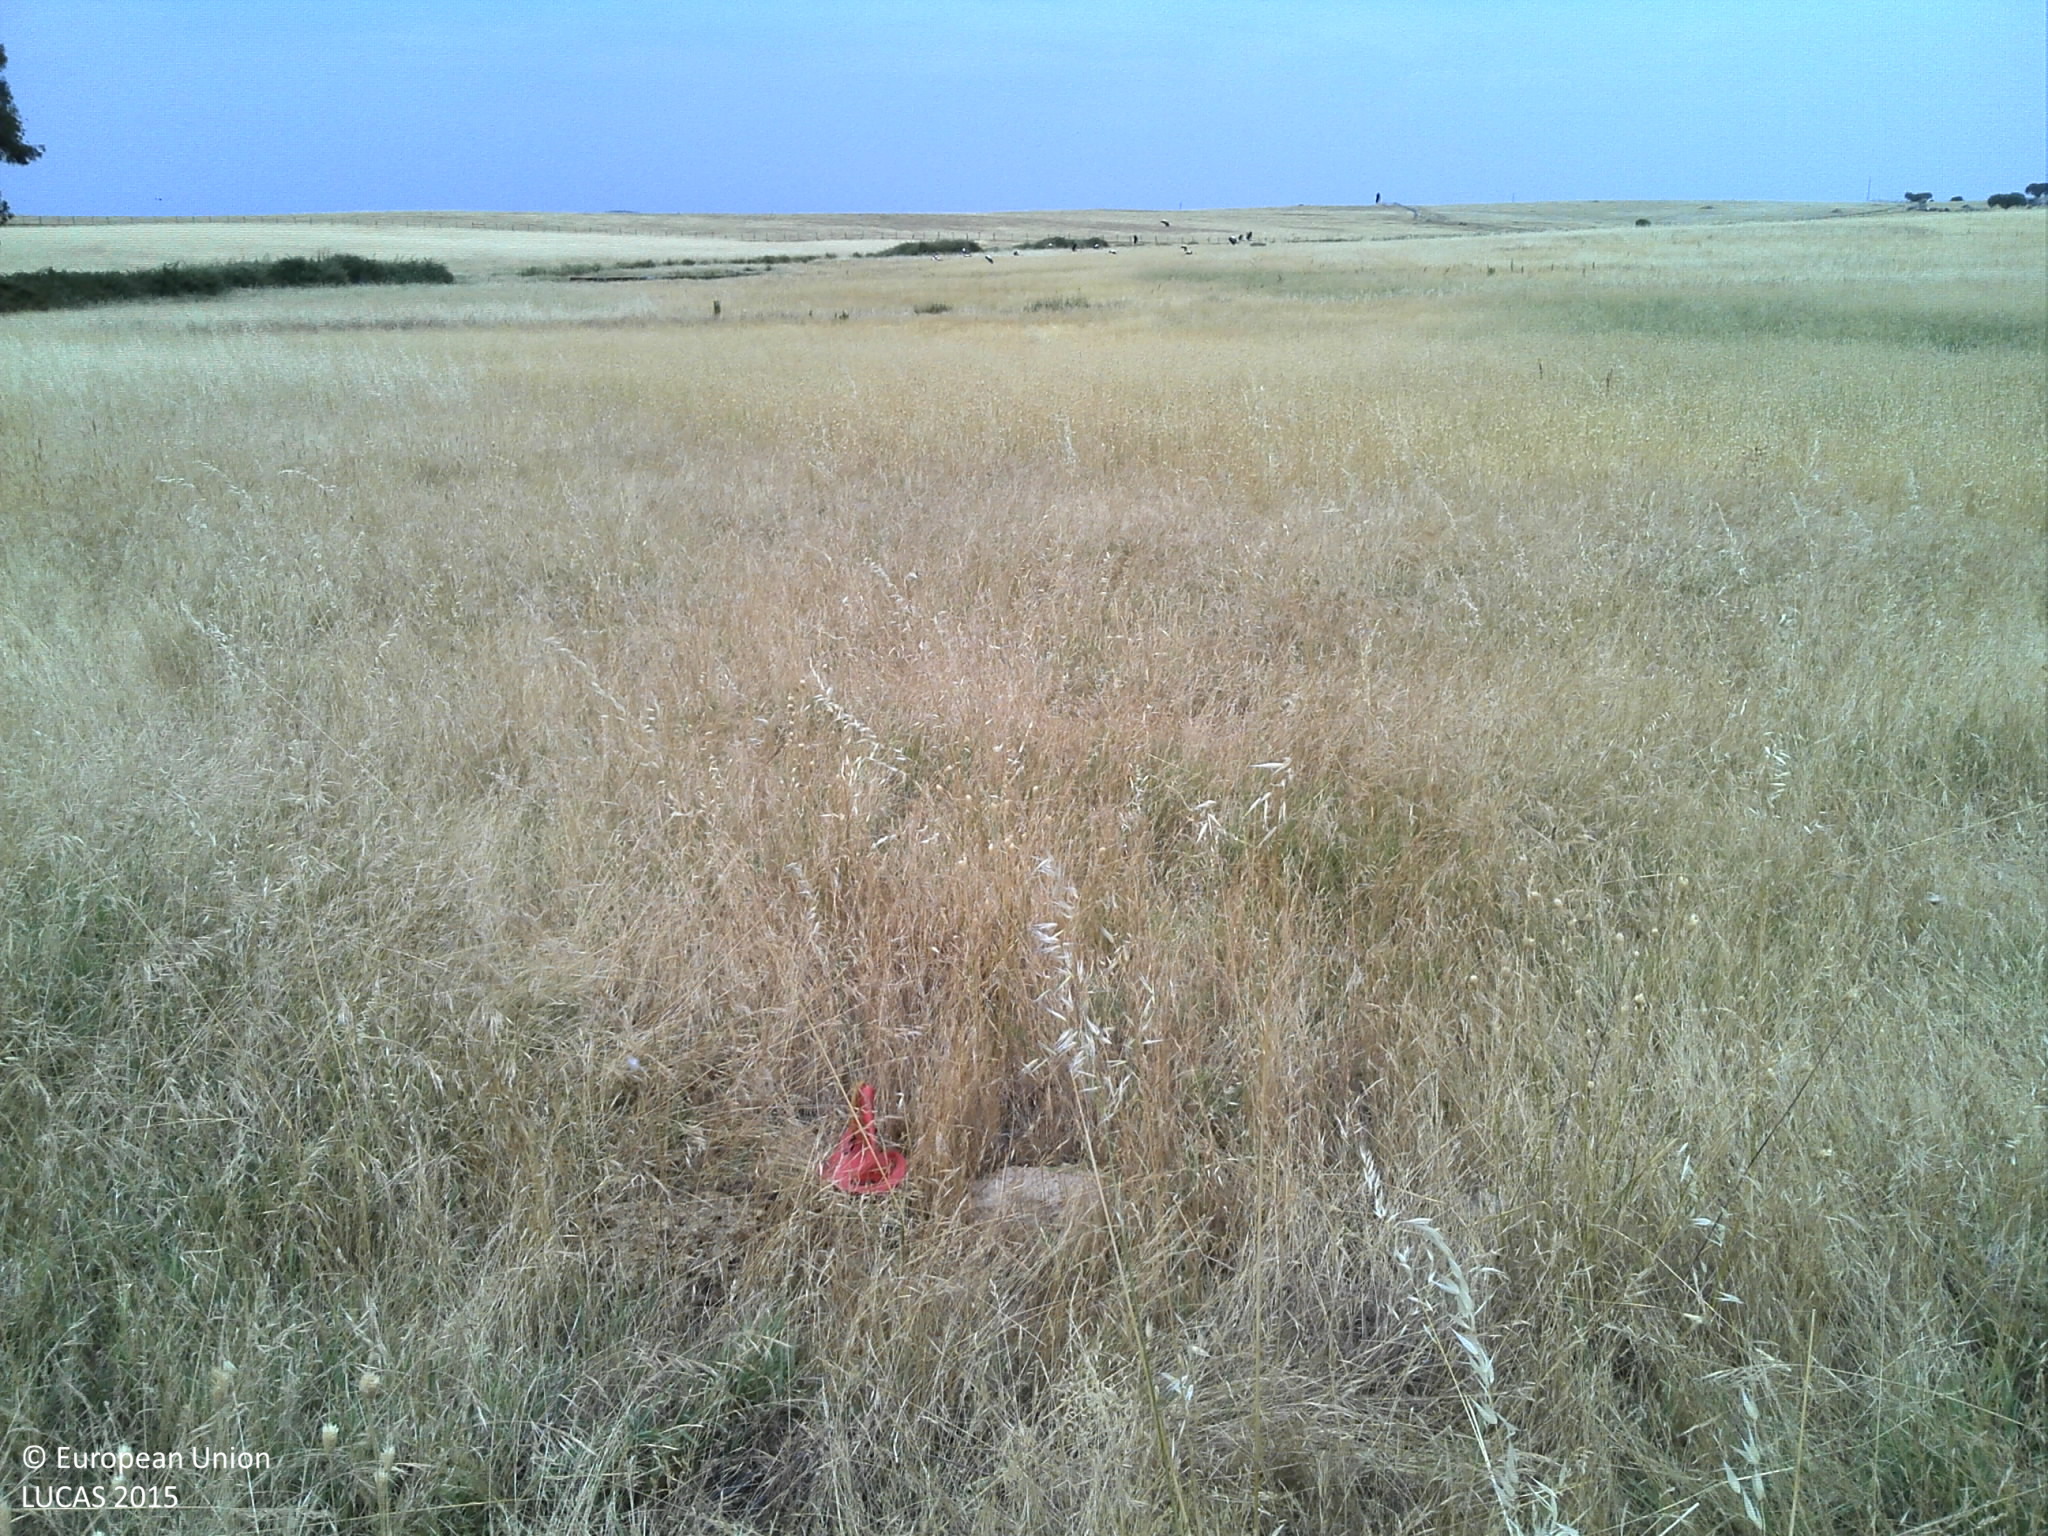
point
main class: Grassland
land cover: Spontaneously vegetated surfaces
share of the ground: 50 - 75 %
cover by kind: herbaceous plants 75 %, unconsolidated bare surface 25 %
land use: Agriculture (excluding fallow land and kitchen gardens)
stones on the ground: < 10 %
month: June
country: PT
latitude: 38.6192
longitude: -7.8293
